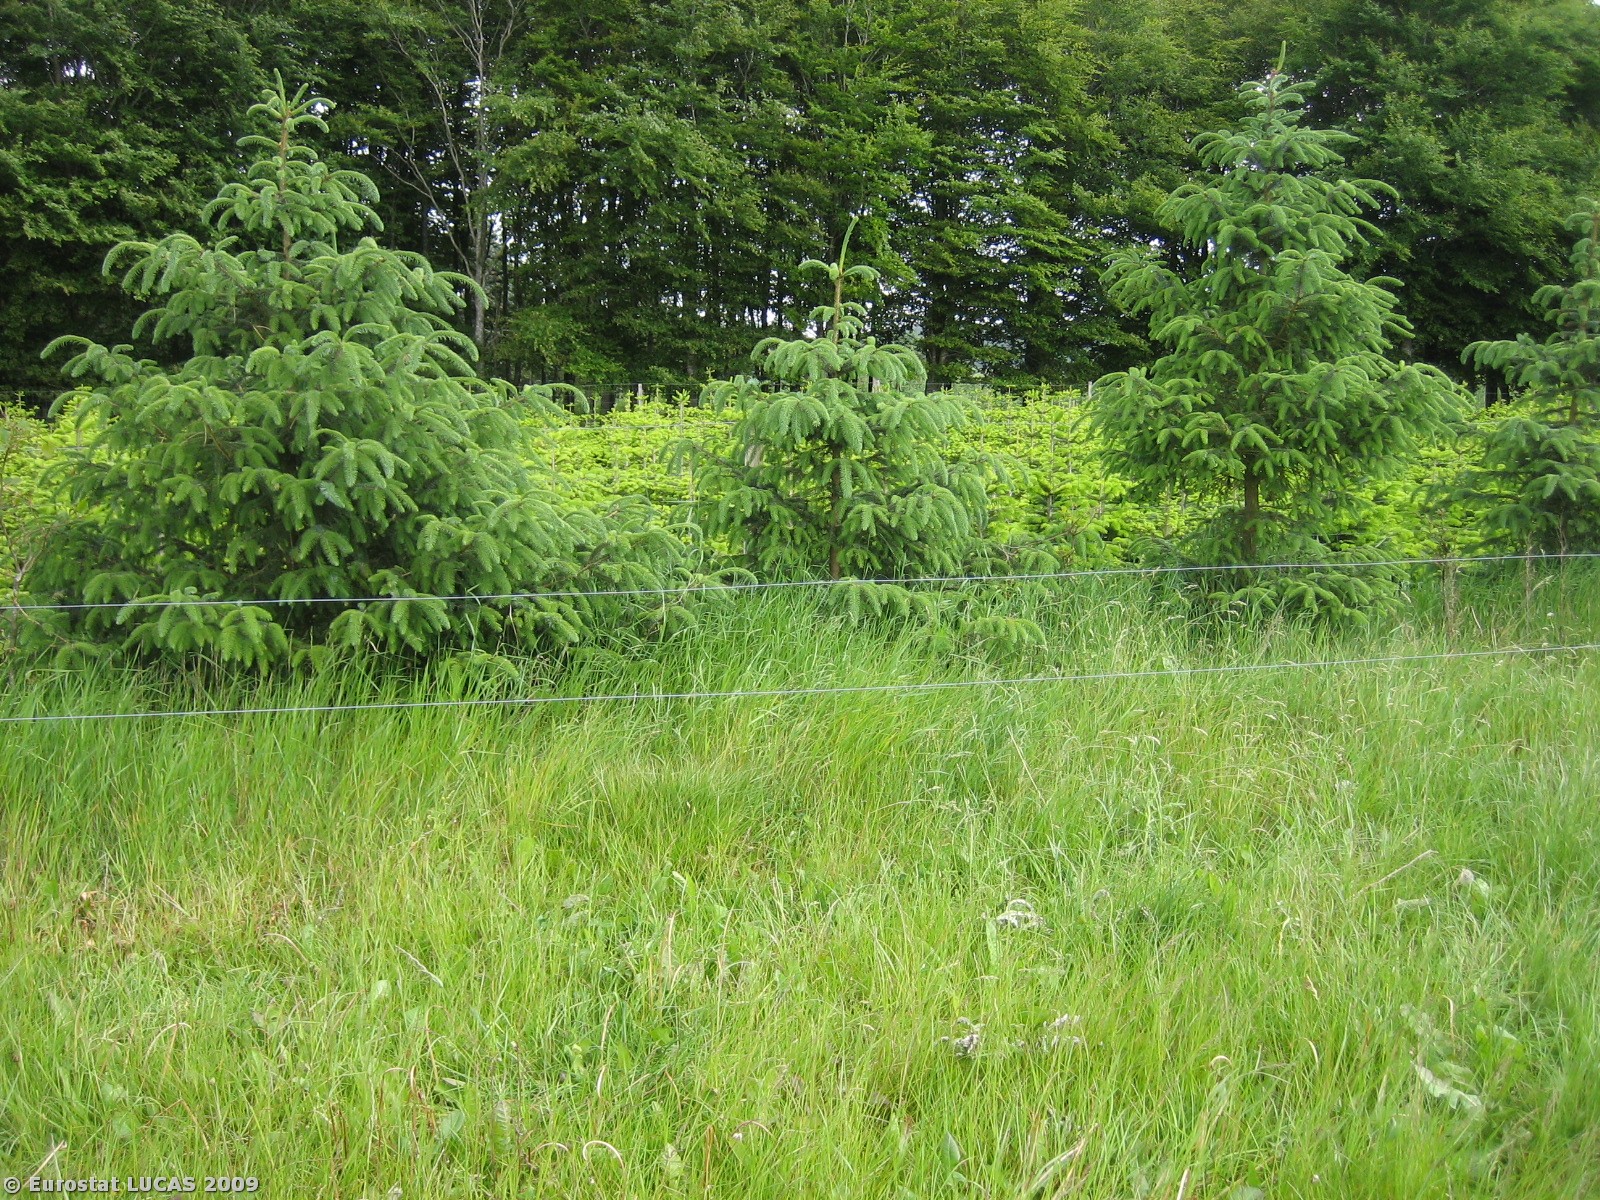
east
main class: Grassland
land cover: Grassland without tree/shrub cover
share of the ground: > 75 %
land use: Agriculture (excluding fallow land and kitchen gardens)
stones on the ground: < 10 %
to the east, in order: Grassland without tree/shrub cover; Fences; Coniferous woodland; Fences; Grass margins; Coniferous woodland; Spontaneously vegetated surfaces; Fences; Broadleaved woodland; Grassland without tree/shrub cover; Fences; Coniferous woodland; Fences; Grassland without tree/shrub cover; Fences; Coniferous woodland; Fences; Grassland with sparse tree/shrub cover; Tracks; Coniferous woodland; Ditches and canals; Grass margins; Coniferous woodland; Tracks; Grass margins; Ditches and canals; Shrubland without tree cover
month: June
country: DK
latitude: 56.2775
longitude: 9.8548
